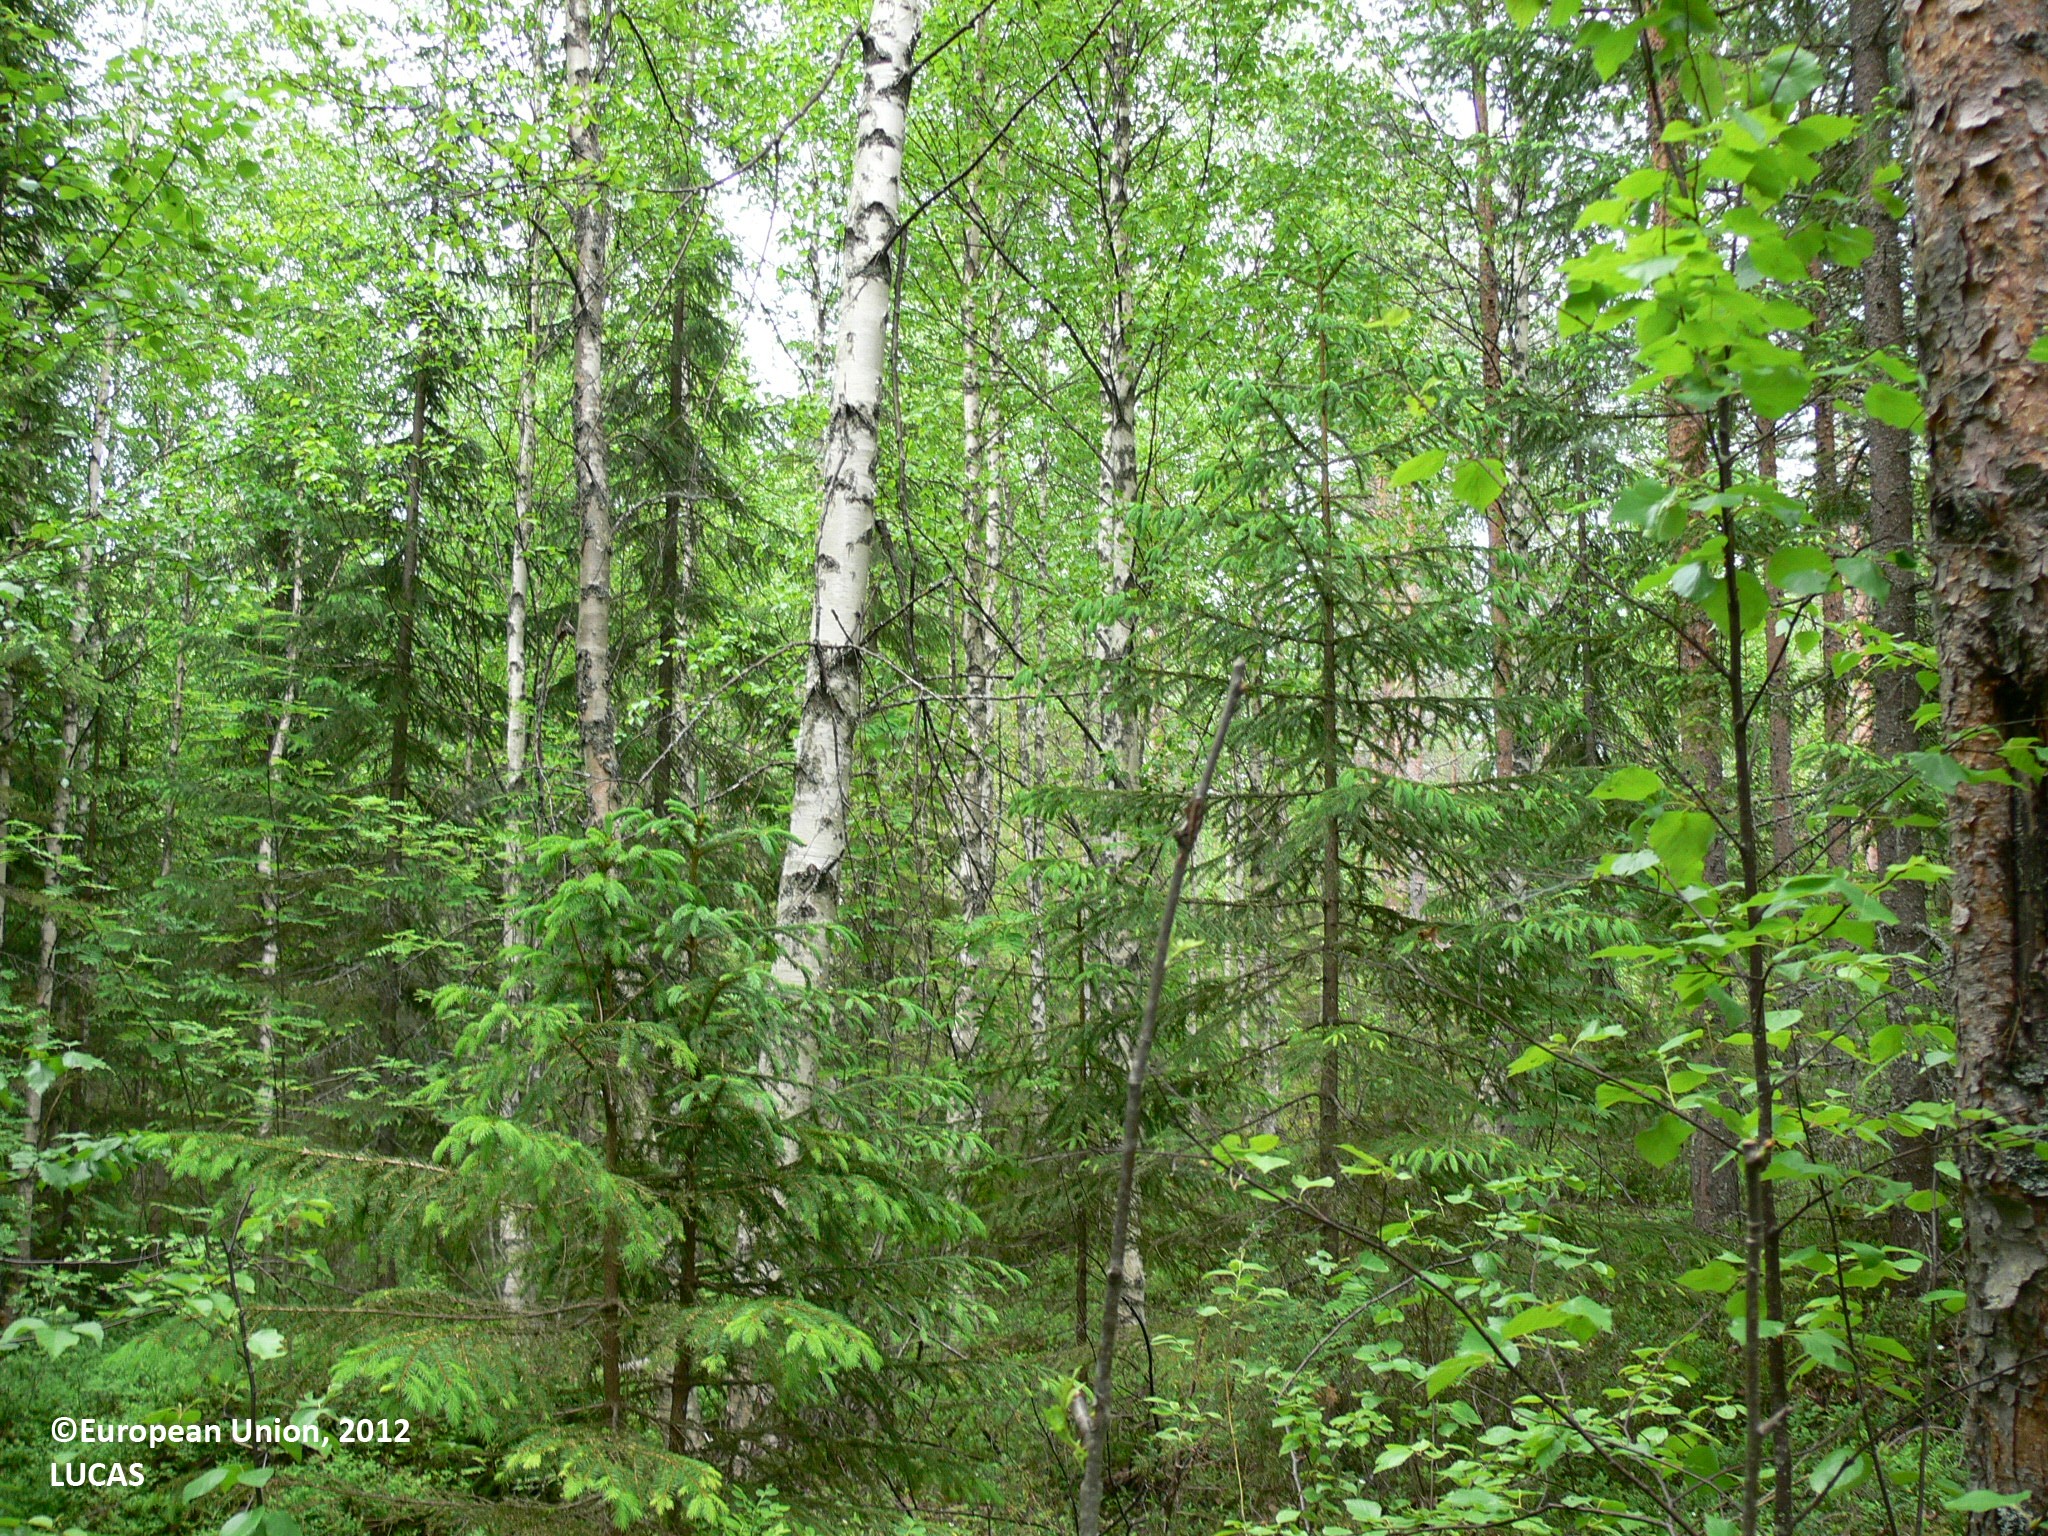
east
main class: Woodland
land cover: Pine dominated mixed woodland
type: boreal forest
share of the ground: > 75 %
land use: Forestry
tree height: > 5 m
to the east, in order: Pine dominated mixed woodland; Pine dominated coniferous woodland; Pine dominated mixed woodland; Spruce dominated mixed woodland; Spruce dominated coniferous woodland; Inland water bodies
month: June
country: FI
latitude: 62.8623
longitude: 29.9647
